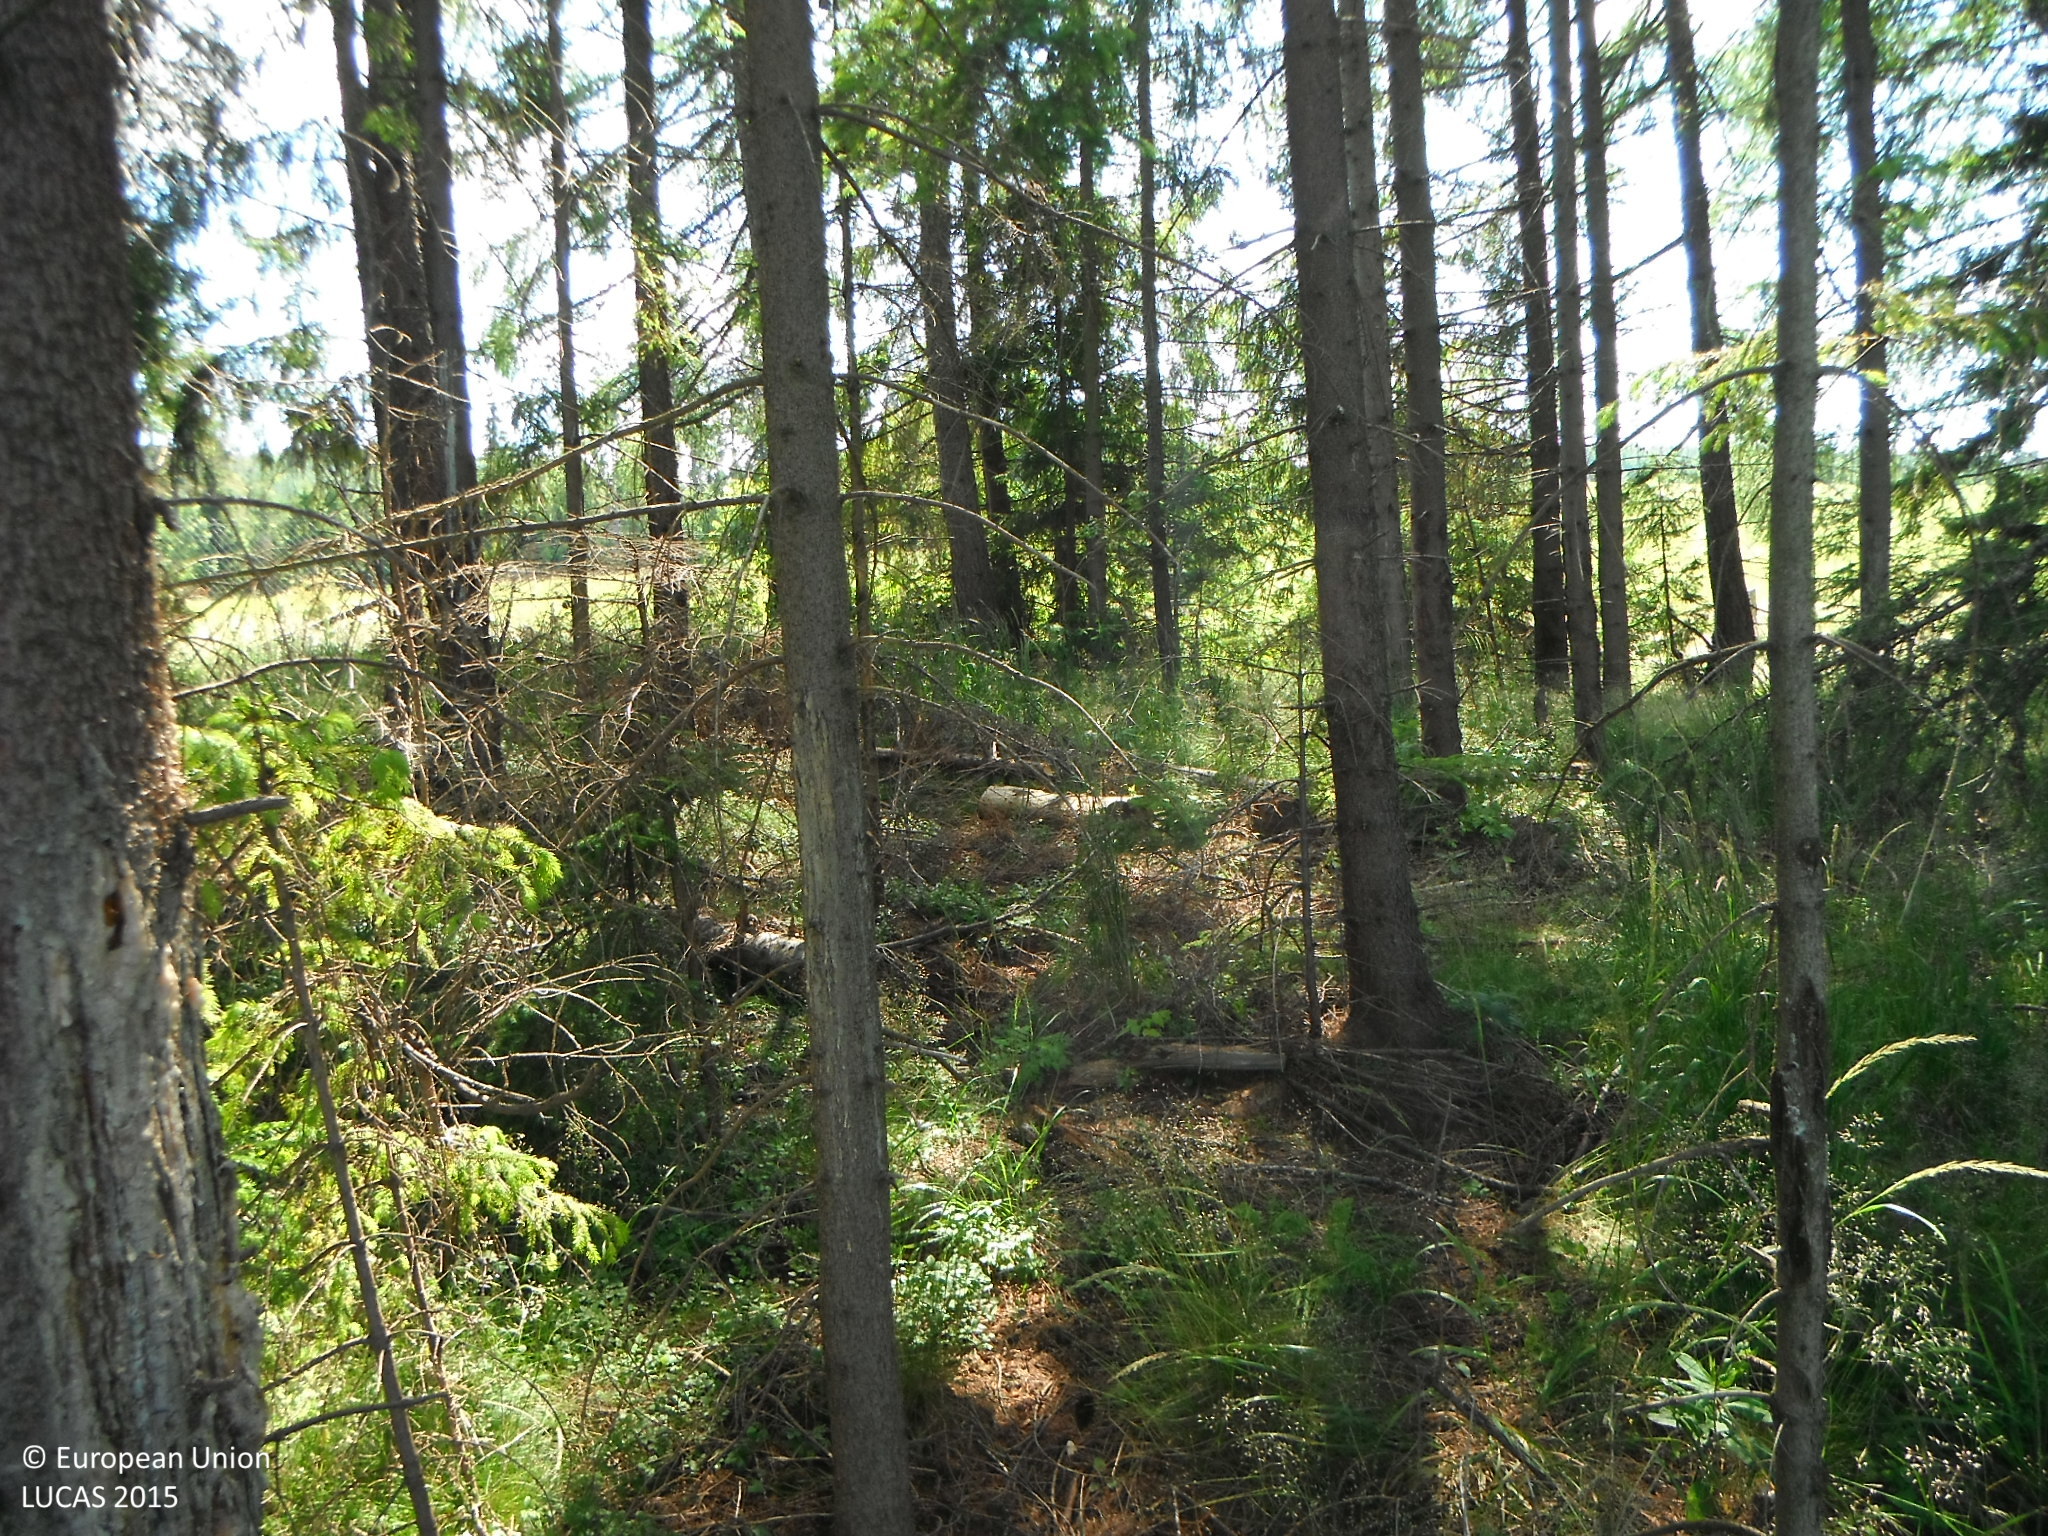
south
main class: Woodland
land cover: Spruce dominated coniferous woodland
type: alpine coniferous forest
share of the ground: > 75 %
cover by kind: coniferous forest trees 85 %, herbaceous plants 15 %
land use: Forestry
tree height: > 5 m
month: July
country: SK
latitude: 48.9762
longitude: 20.2665
